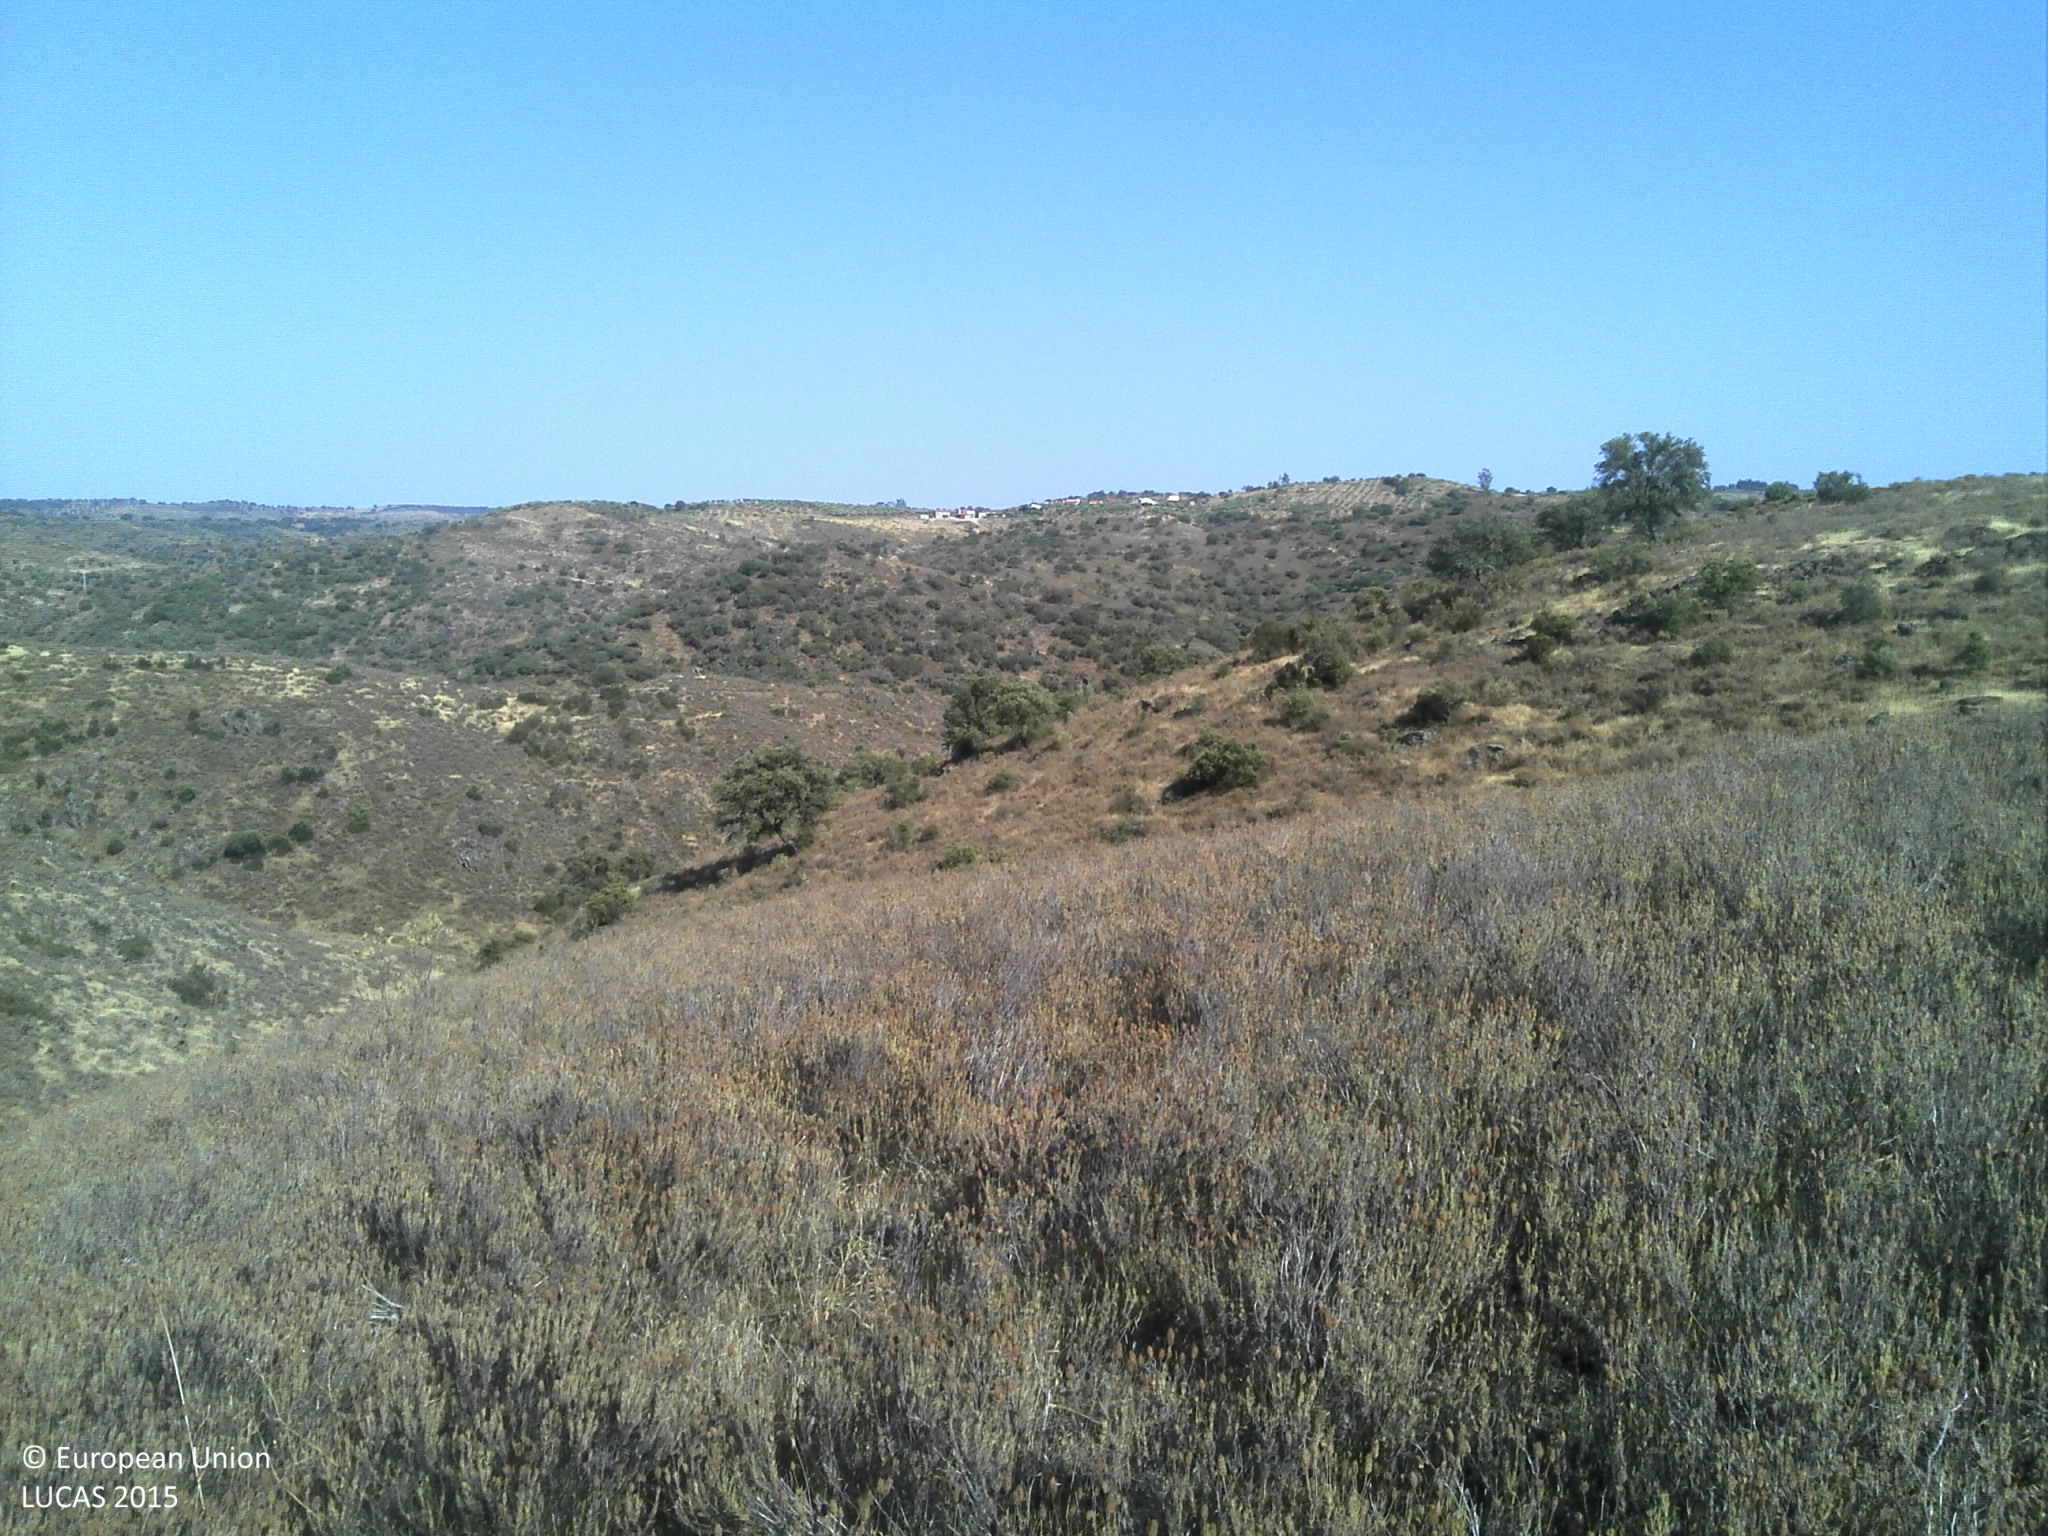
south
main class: Shrubland
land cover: Shrubland without tree cover
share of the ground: 50 - 75 %
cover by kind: shrubs 70 %, herbaceous plants 15 %, unconsolidated bare surface 10 %
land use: Abandoned areas
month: June
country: PT
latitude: 39.7304
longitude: -7.2068
